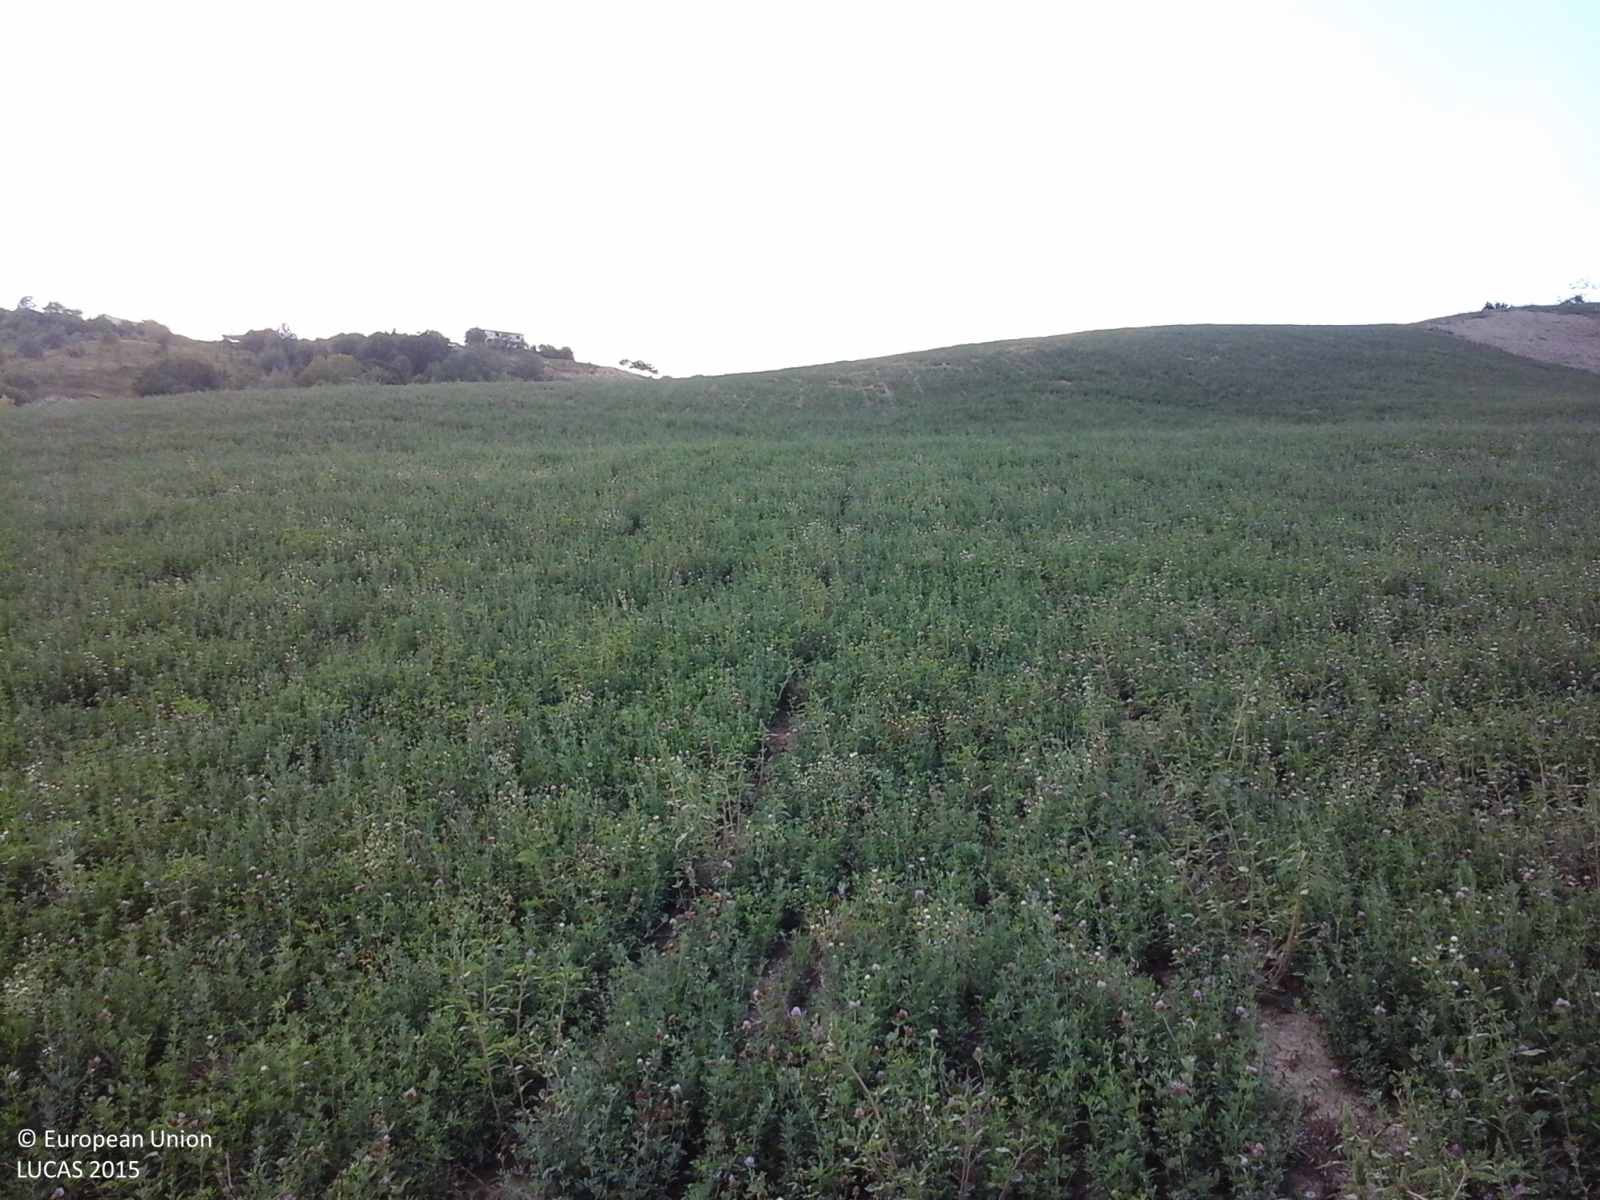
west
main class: Cropland
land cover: Lucerne
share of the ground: > 75 %
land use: Agriculture (excluding fallow land and kitchen gardens)
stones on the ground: < 10 %
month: August
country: IT
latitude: 42.5628
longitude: 13.8499
